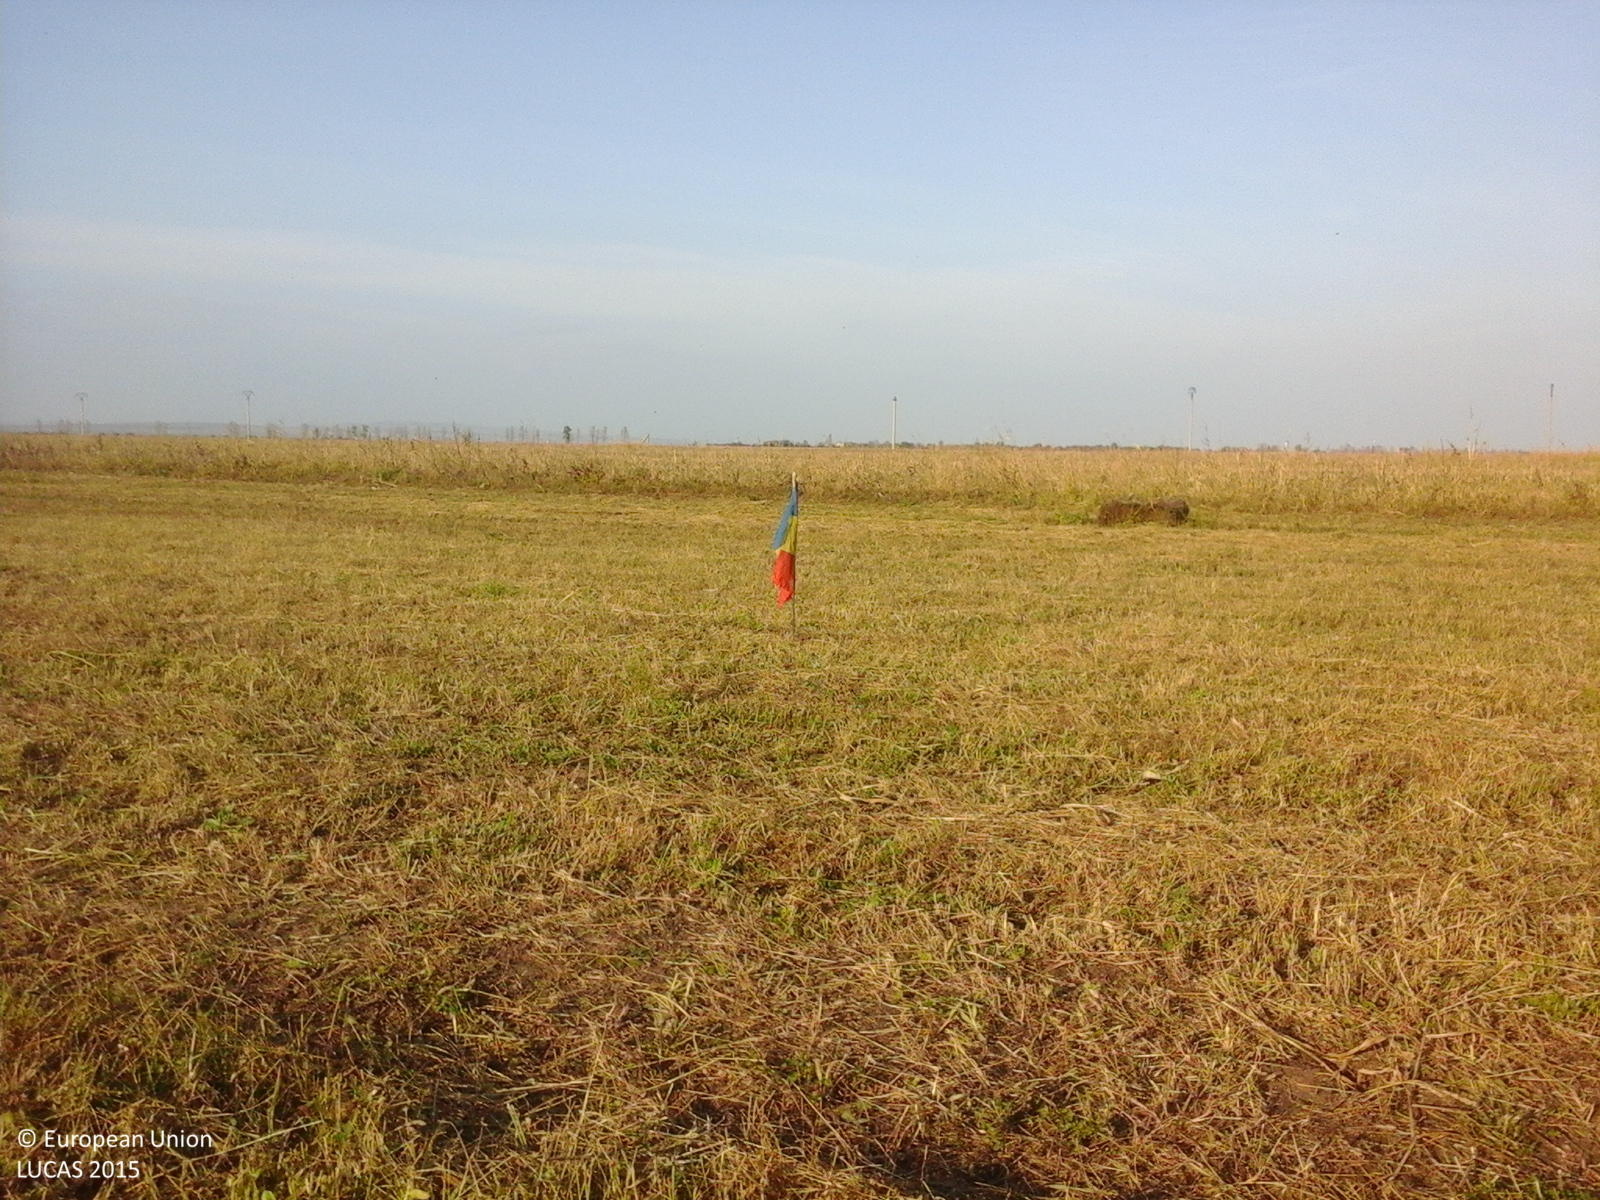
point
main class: Cropland
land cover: Lucerne
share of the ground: > 75 %
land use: Agriculture (excluding fallow land and kitchen gardens)
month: October
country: RO
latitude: 45.1924
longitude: 26.9229
